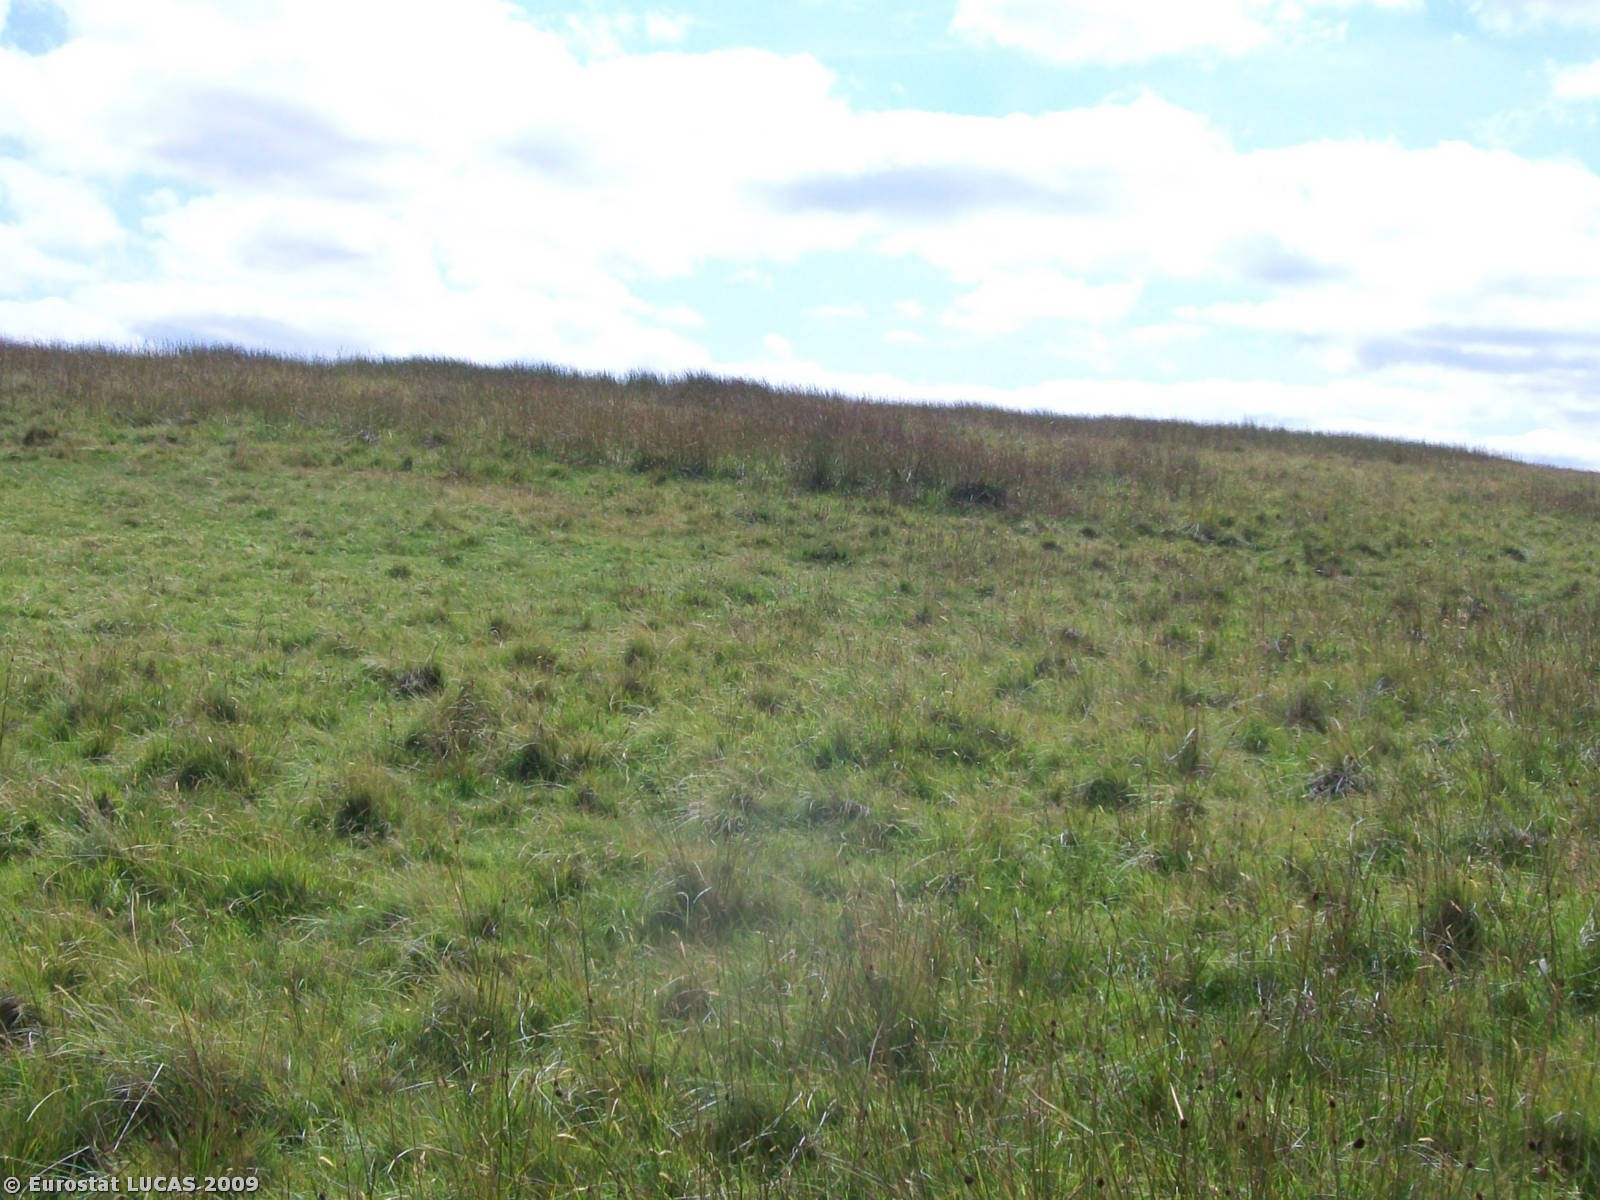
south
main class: Grassland
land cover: Grassland without tree/shrub cover
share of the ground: > 75 %
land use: Agriculture (excluding fallow land and kitchen gardens)
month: August
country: GB
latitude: 52.4444
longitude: -3.3070
